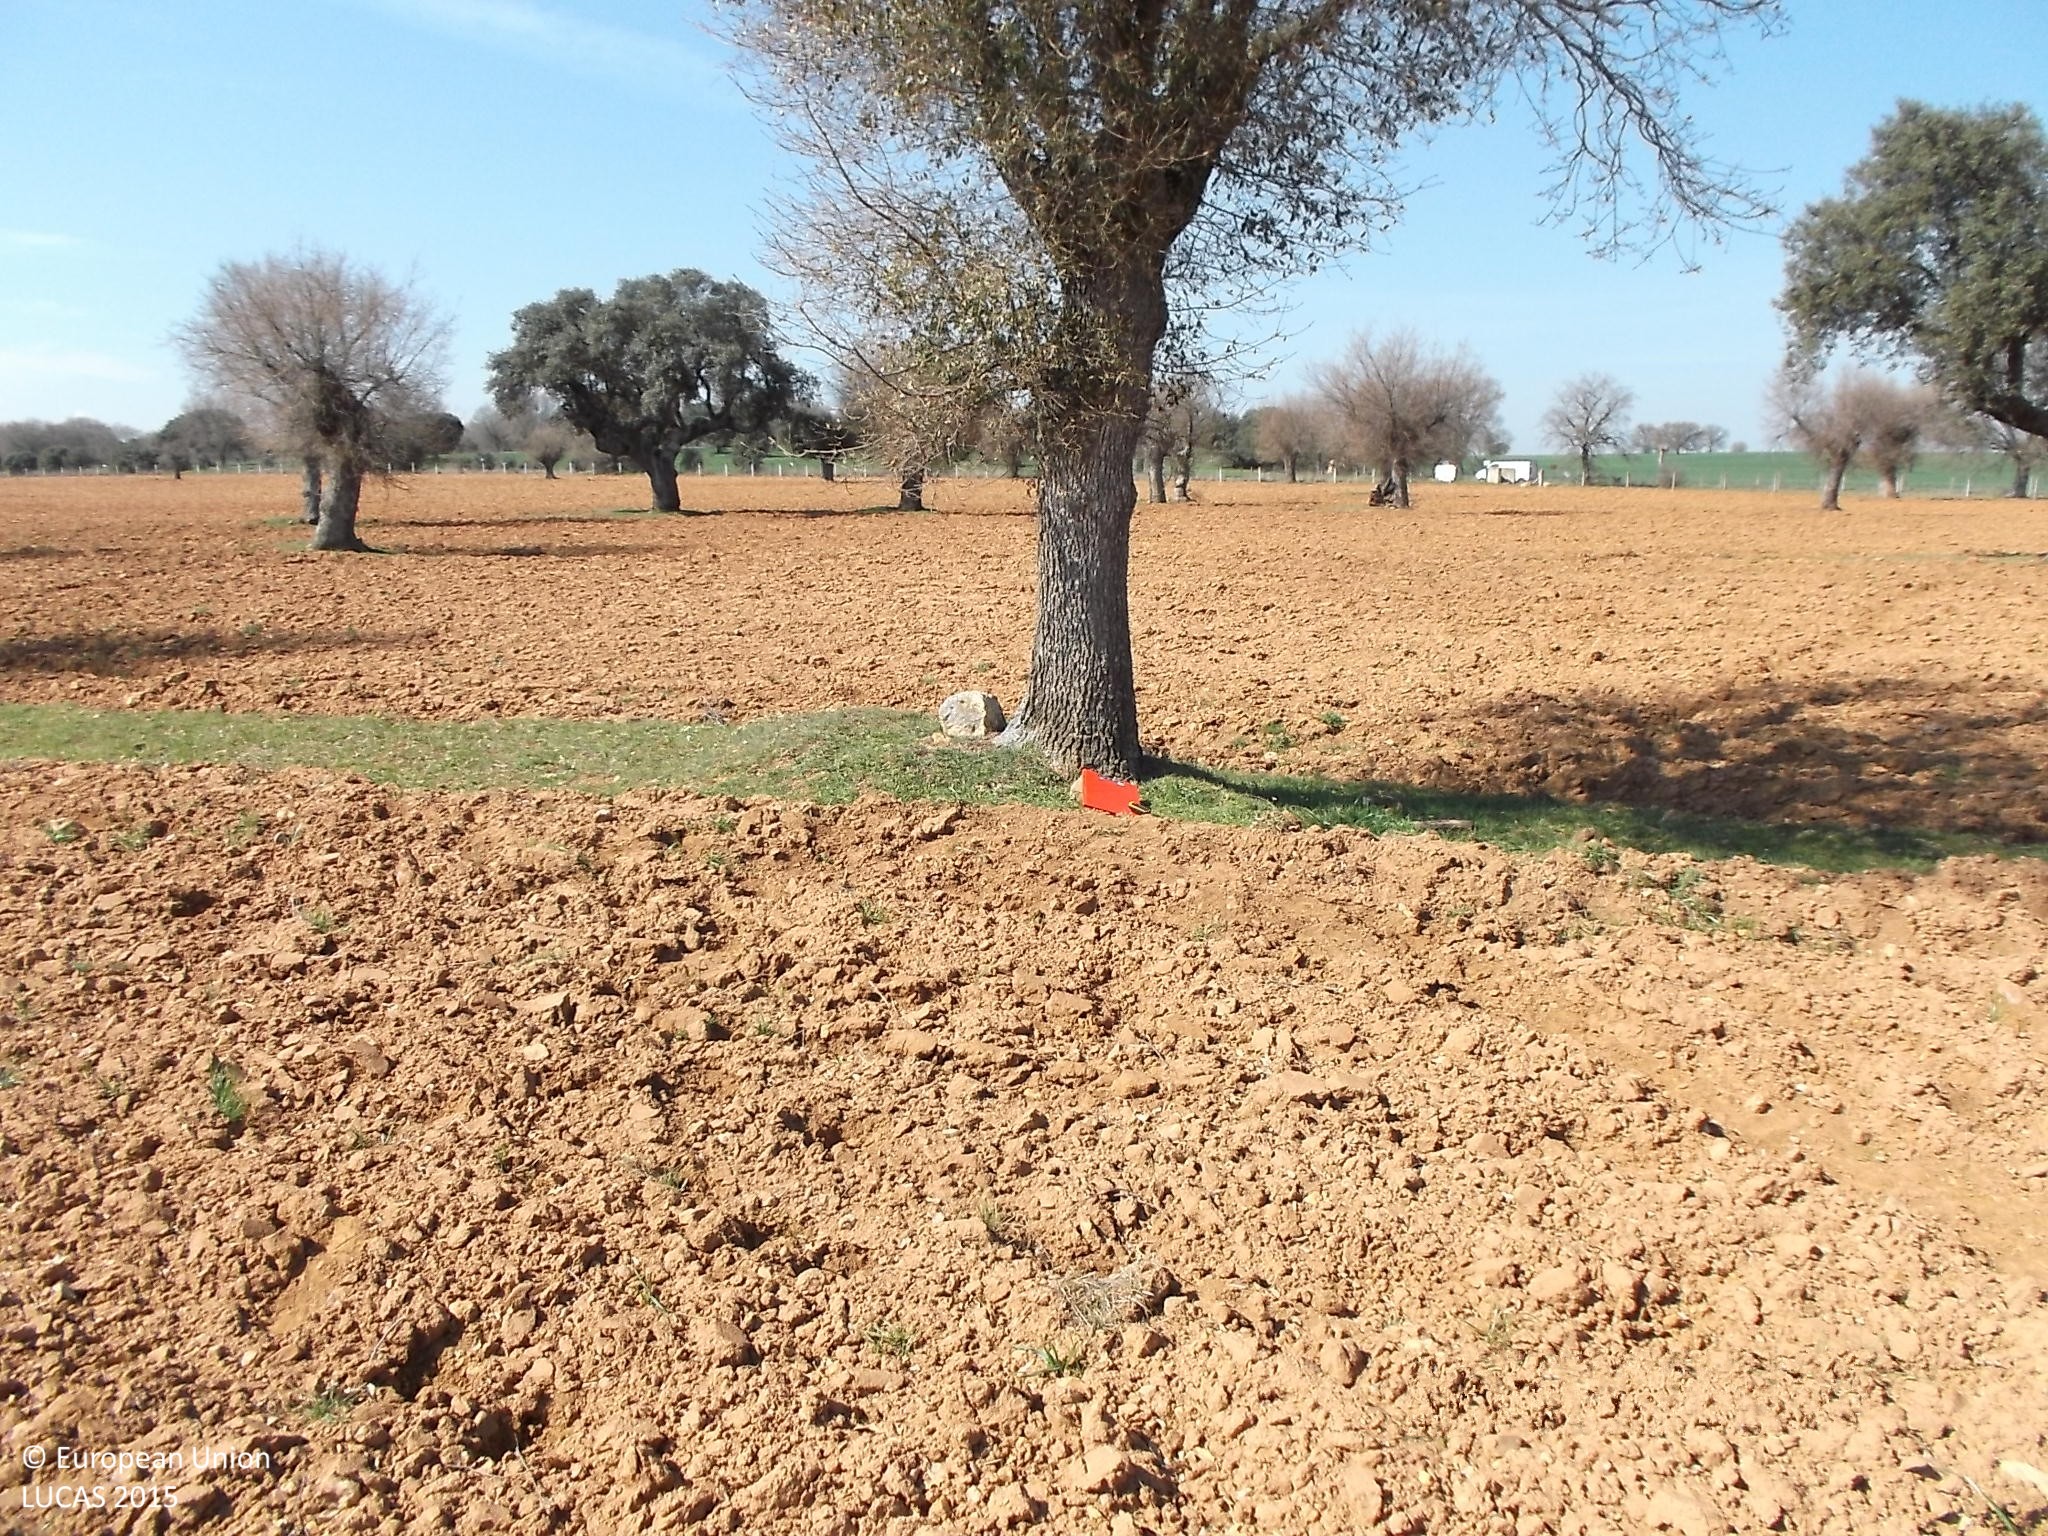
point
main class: Woodland
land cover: Broadleaved woodland
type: broadleaved evergreen forest
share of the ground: 10 - 25 %
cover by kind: unconsolidated bare surface 85 %, broadleaved forest trees 15 %
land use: Forestry
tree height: < 5 m
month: April
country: ES
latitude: 40.8568
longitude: -5.8934
